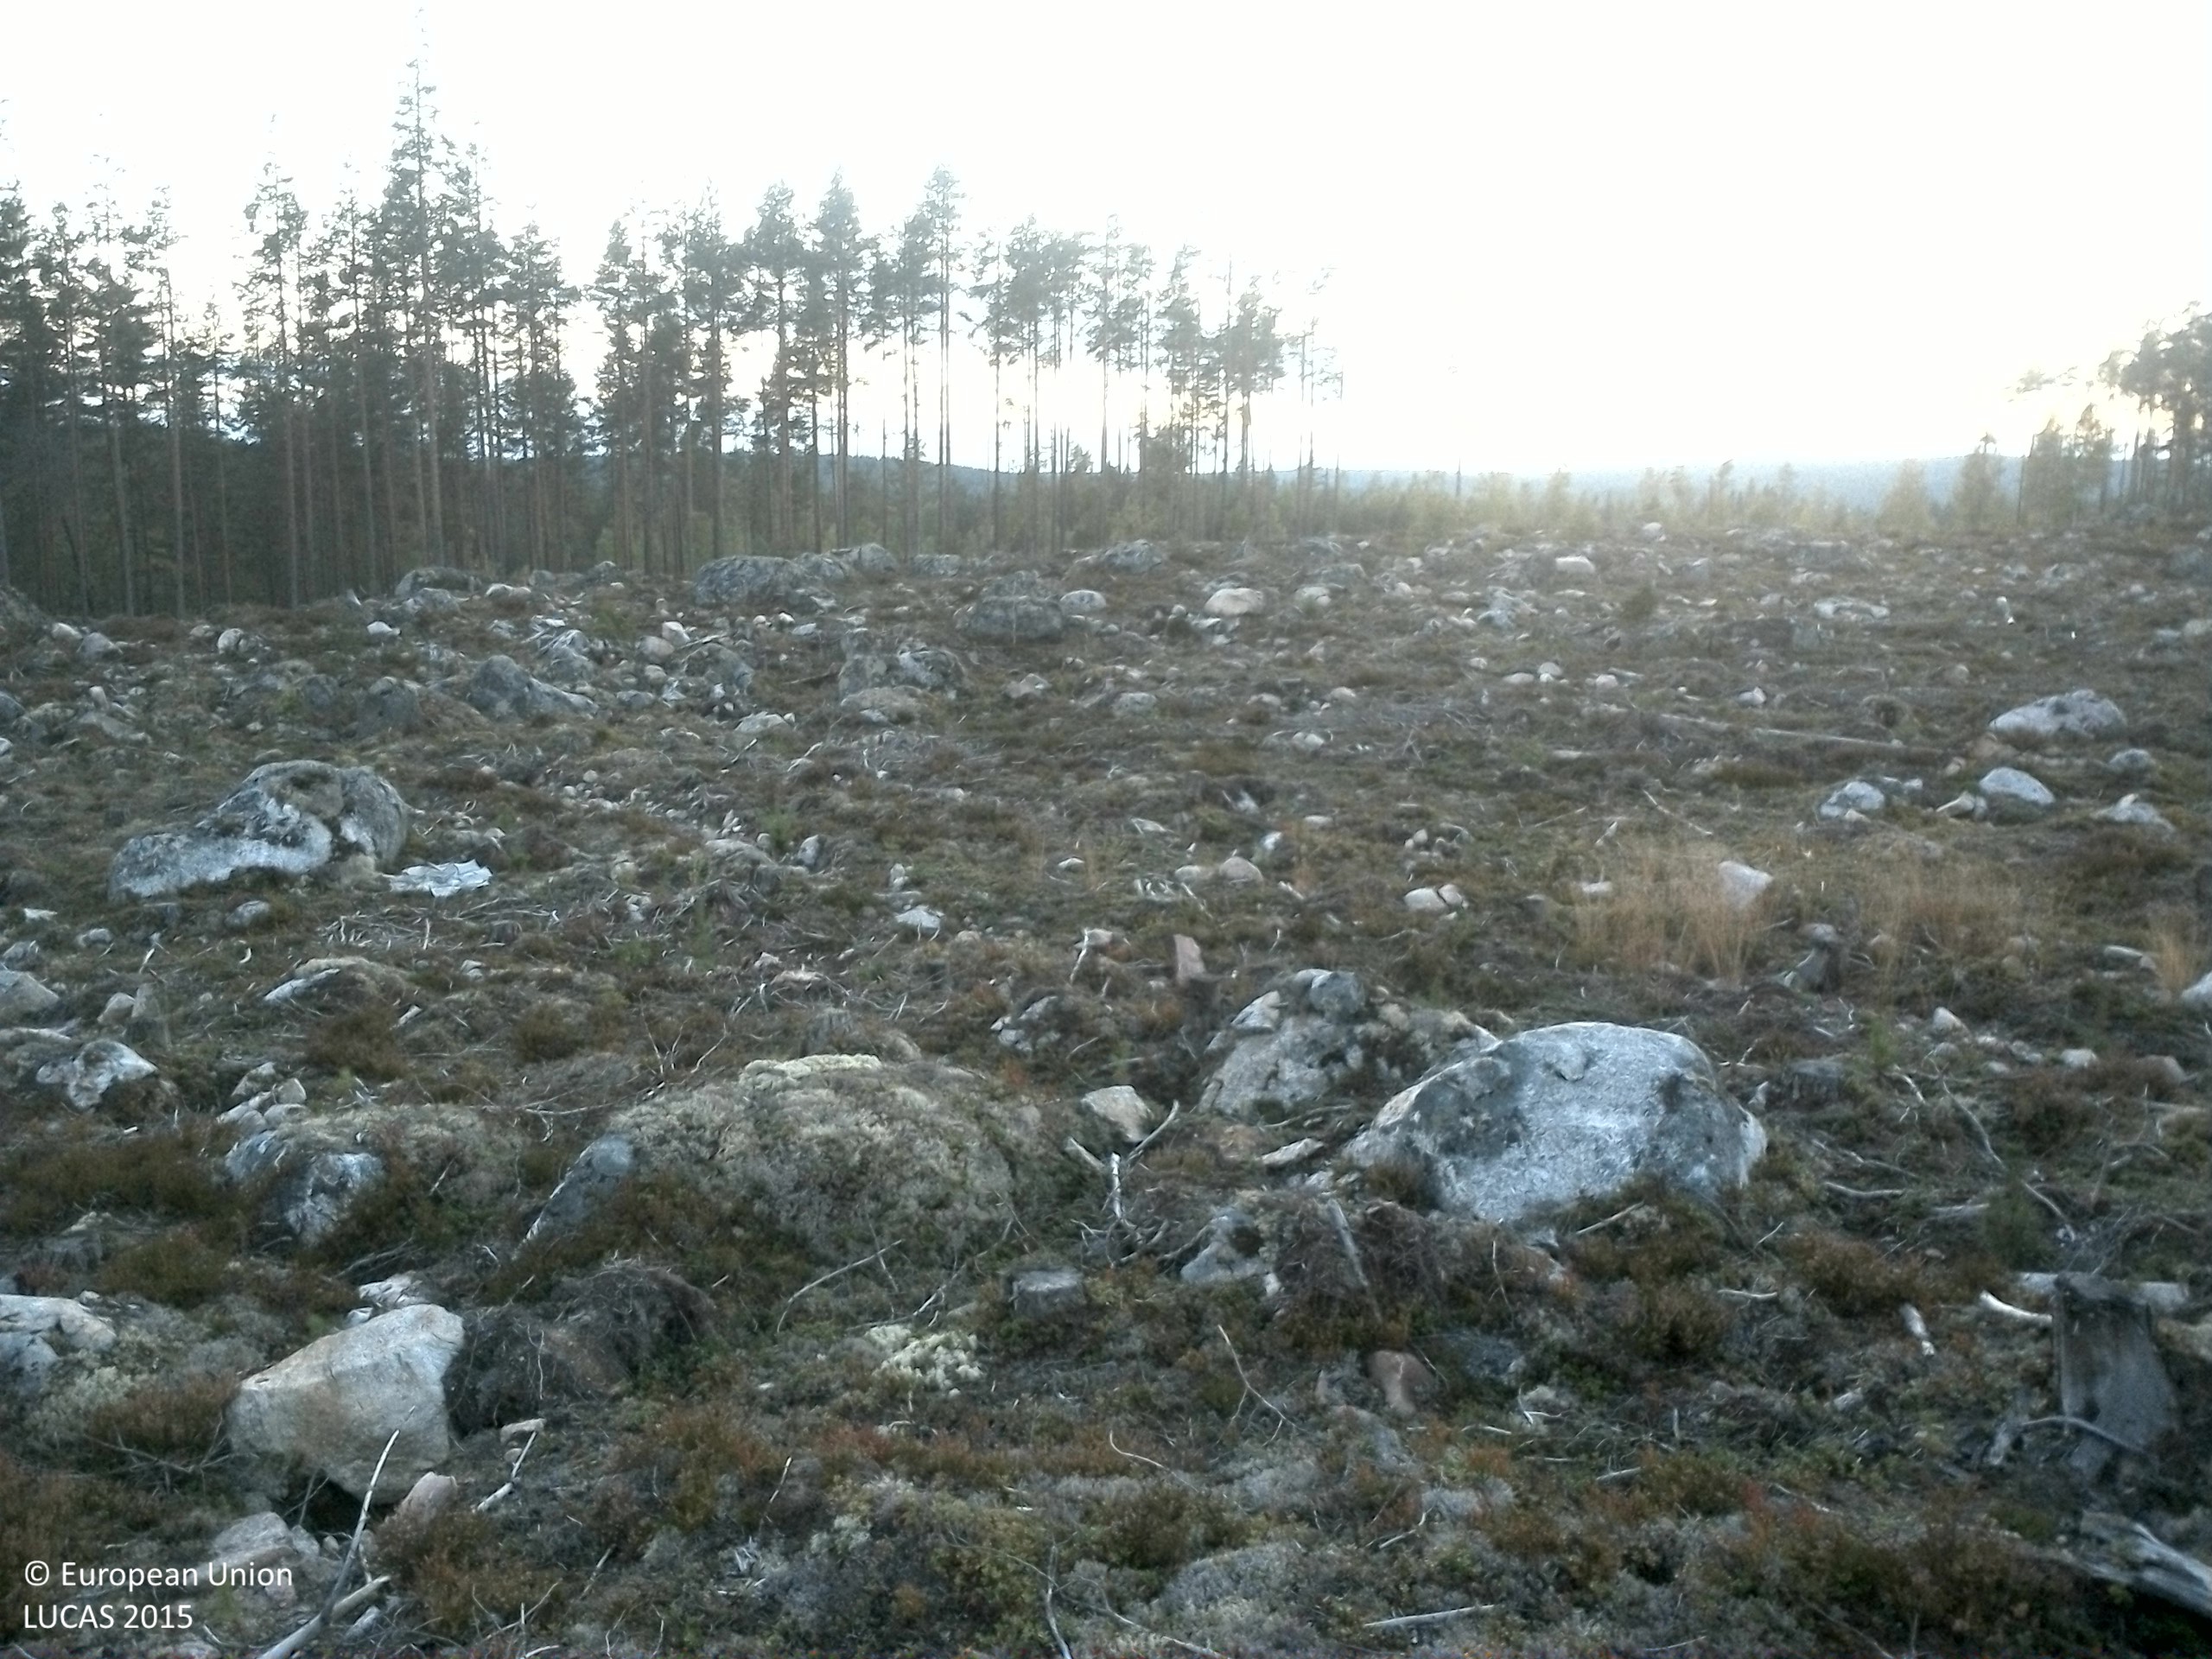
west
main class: Shrubland
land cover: Shrubland without tree cover
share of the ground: 50 - 75 %
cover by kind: shrubs 50 %, consolidated bare surface 40 %, lichens and mosses 10 %
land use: Forestry
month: September
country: SE
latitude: 61.5943
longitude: 15.3918
